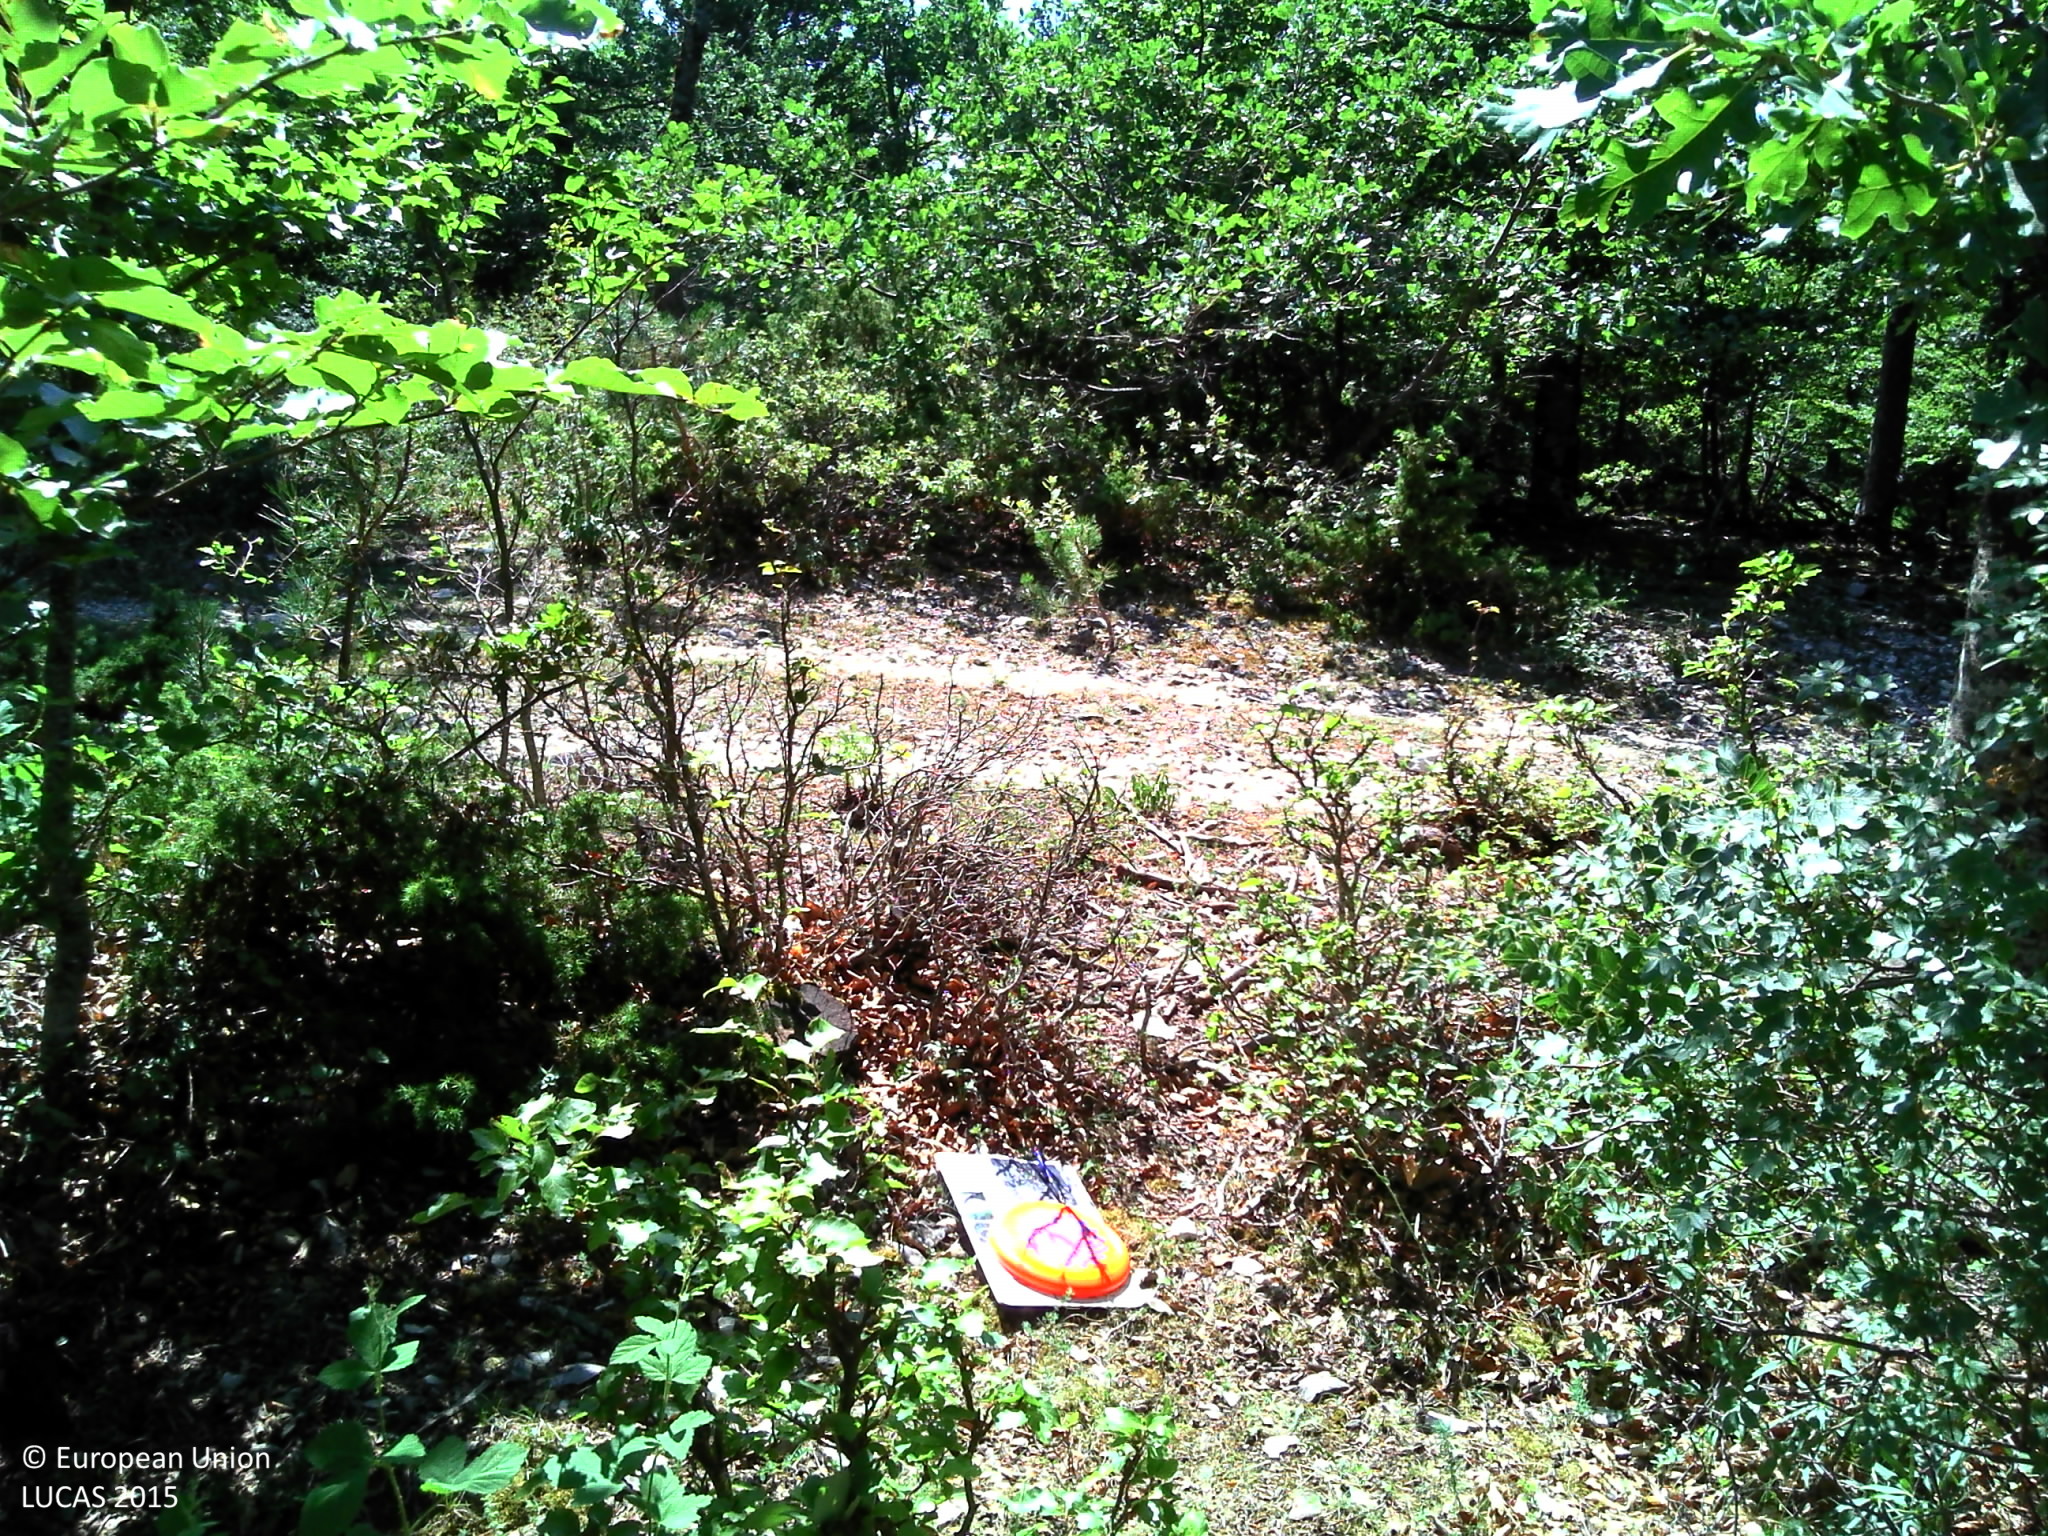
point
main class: Woodland
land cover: Broadleaved woodland
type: broadleaved evergreen forest
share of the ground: > 75 %
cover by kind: broadleaved forest trees 75 %, shrubs 20 %, herbaceous plants 5 %
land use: Semi-natural and natural areas not in use
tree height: > 5 m
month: July
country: FR
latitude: 44.1355
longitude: 5.2957
